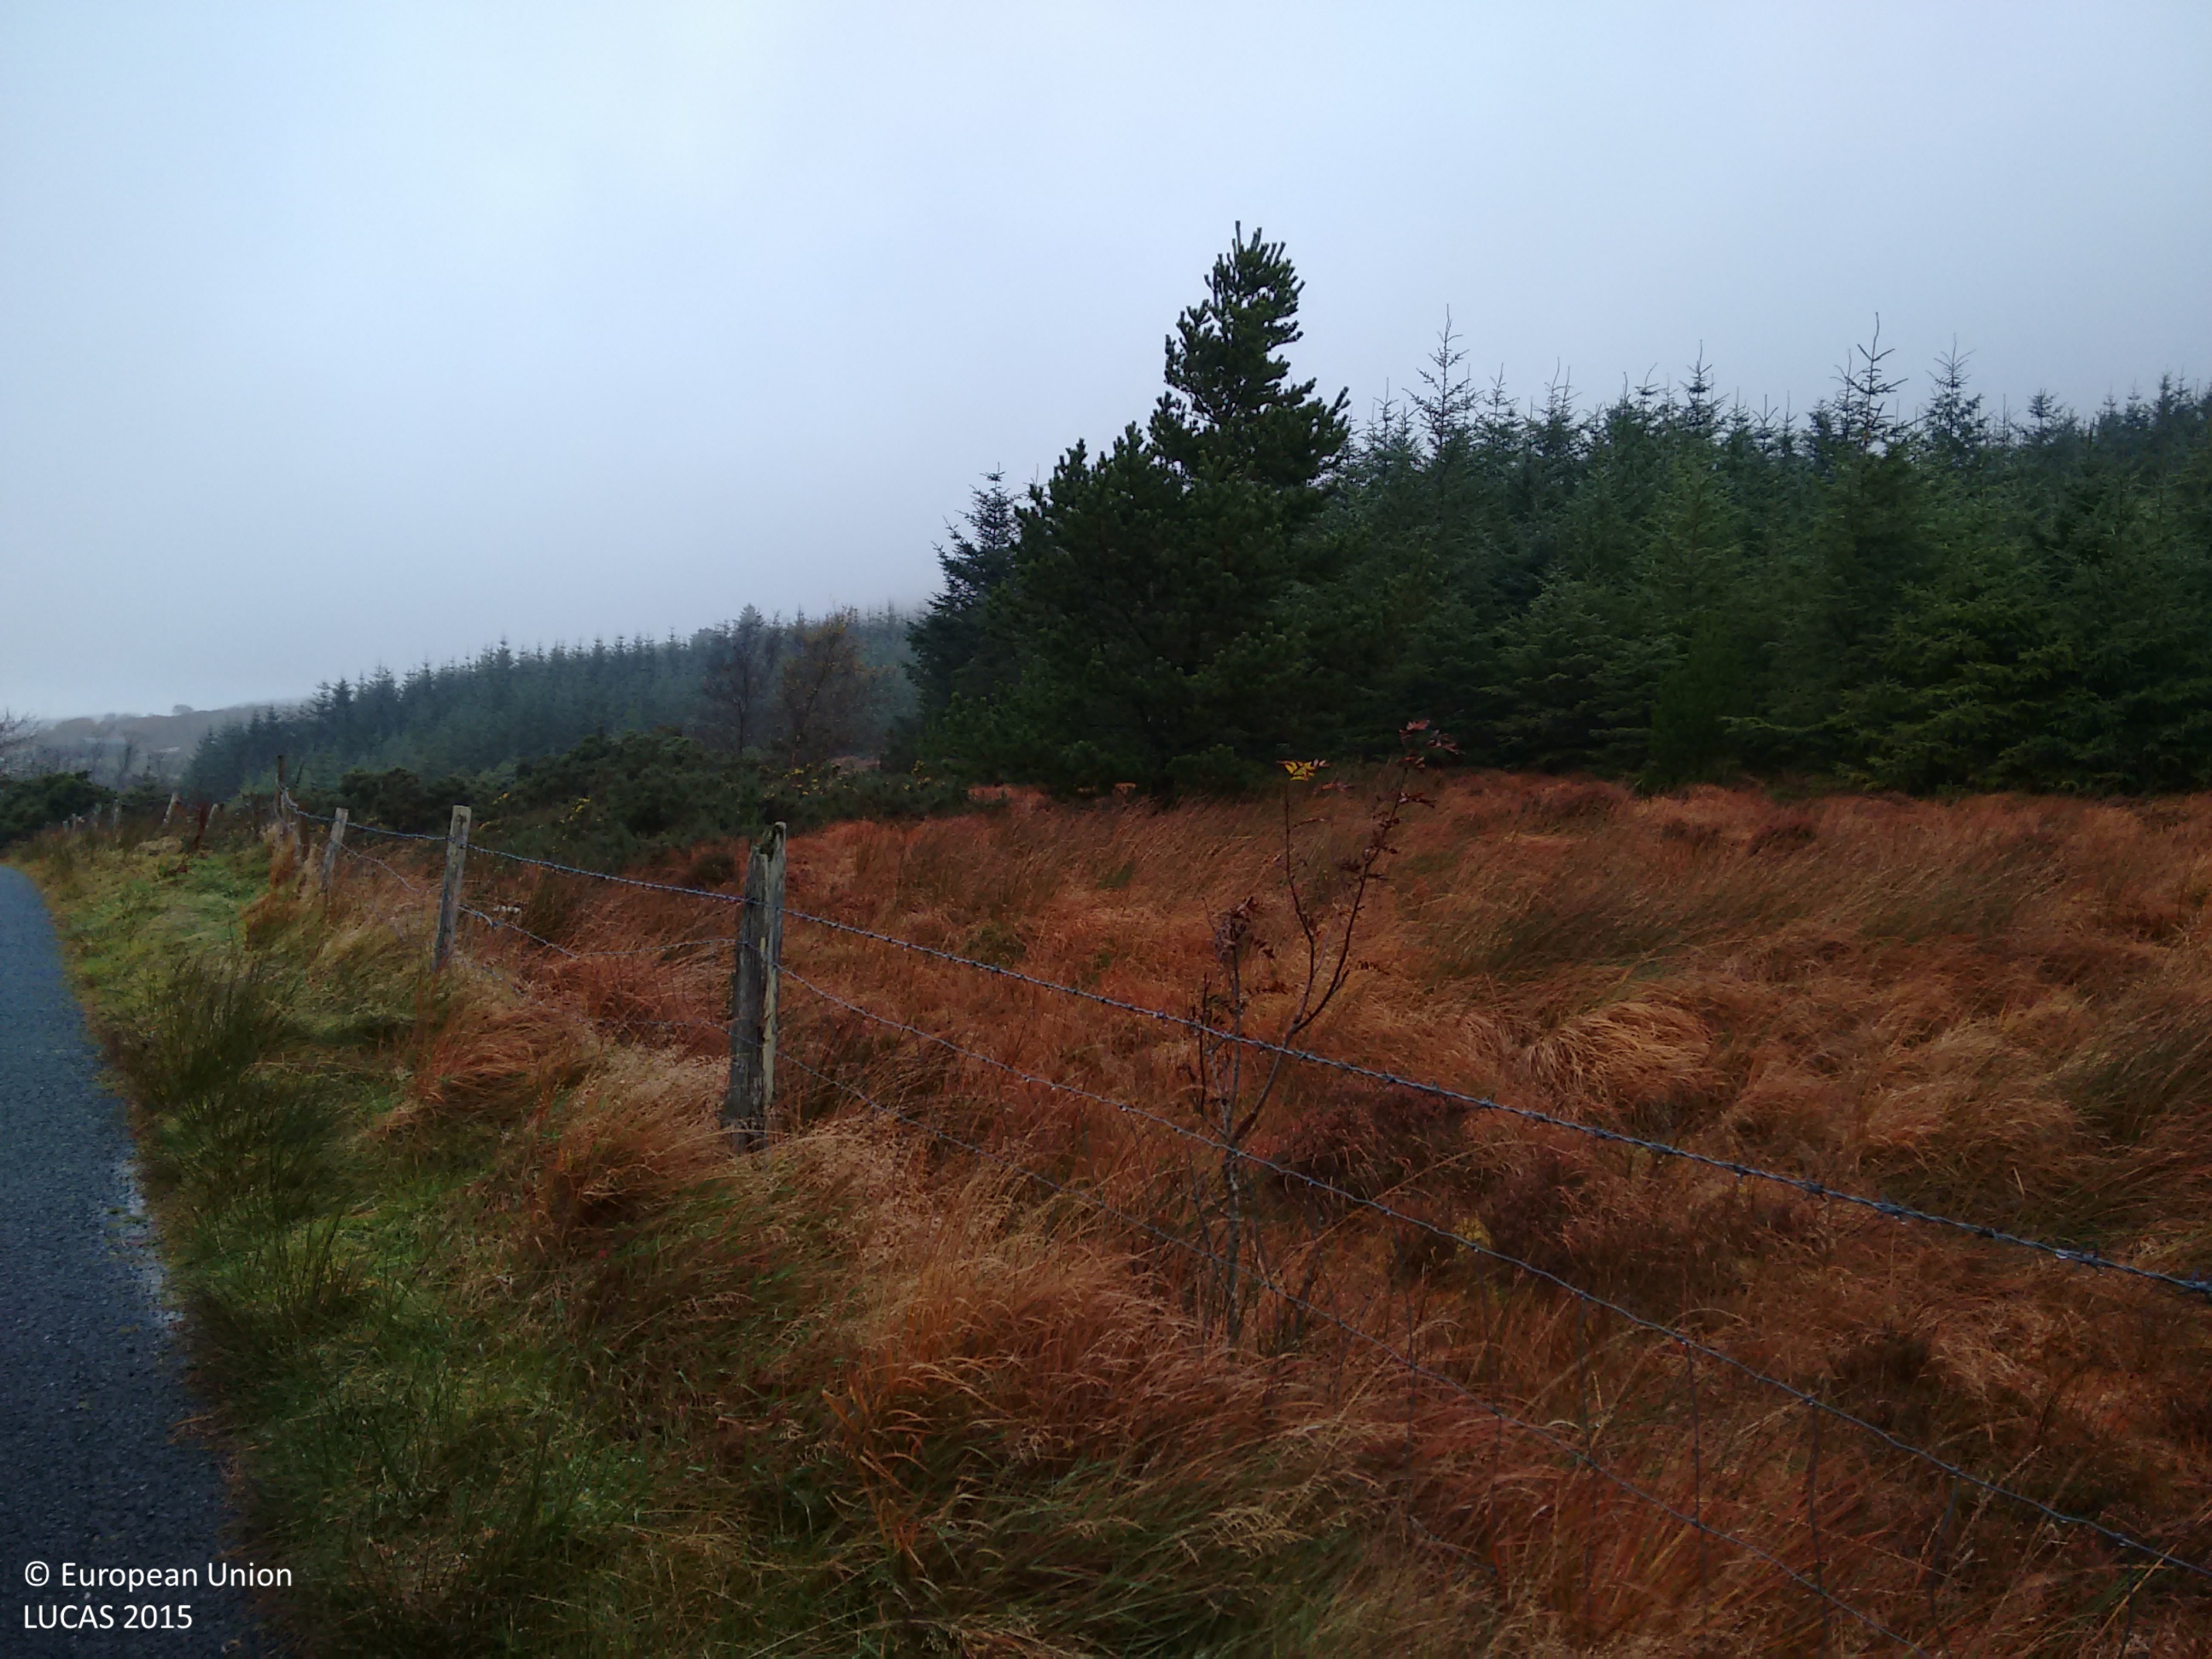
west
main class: Woodland
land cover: Spruce dominated coniferous woodland
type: exotic forest
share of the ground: > 75 %
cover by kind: coniferous forest trees 90 %, herbaceous plants 10 %
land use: Forestry
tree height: > 5 m
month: November
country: IE
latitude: 54.8239
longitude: -8.2517
